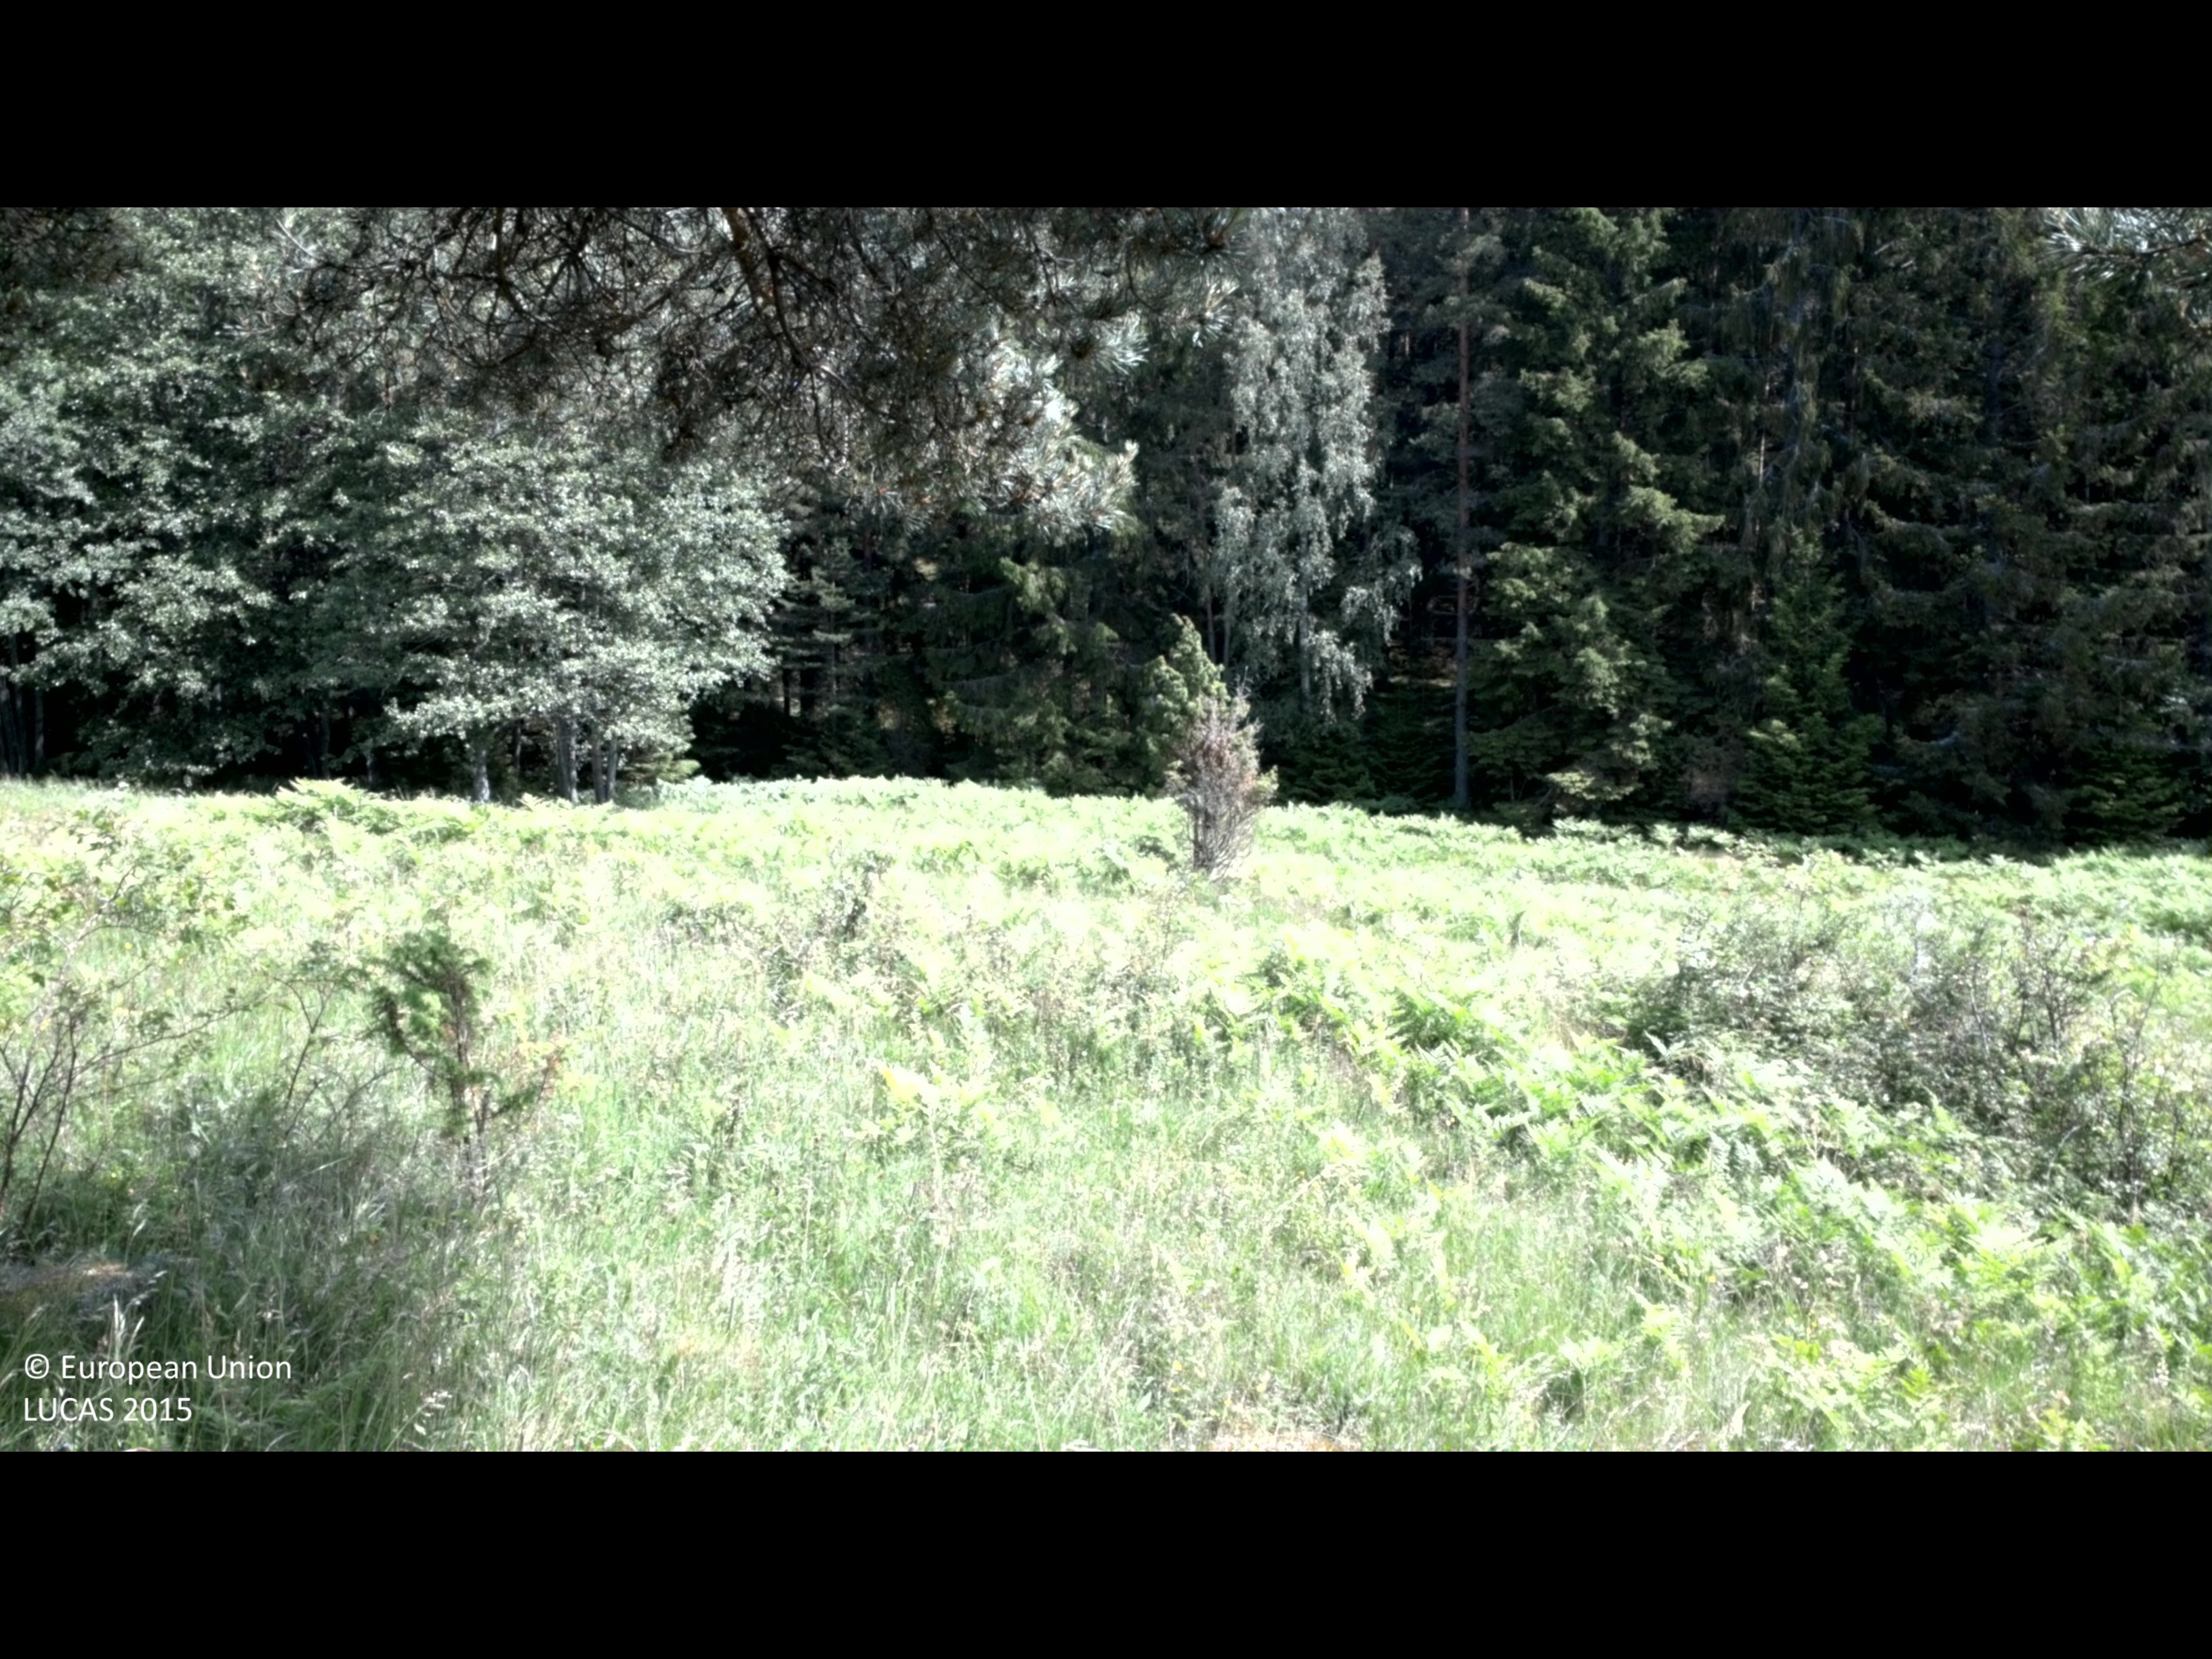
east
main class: Woodland
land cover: Pine dominated mixed woodland
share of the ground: 25 - 50 %
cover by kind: herbaceous plants 35 %, coniferous forest trees 30 %, shrubs 20 %, broadleaved forest trees 15 %
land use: Agriculture (excluding fallow land and kitchen gardens)
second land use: Forestry
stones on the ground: 25 - 50 %
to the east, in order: Pine dominated mixed woodland; Grassland with sparse tree/shrub cover; Ditches and canals; Grassland with sparse tree/shrub cover; Other coniferous woodland; Fences; Other coniferous woodland; Pine dominated coniferous woodland; Shrubland with sparse tree cover; Other coniferous woodland; Shrubland with sparse tree cover; Other mixed woodland
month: June
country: SE
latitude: 58.0221
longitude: 16.5835
